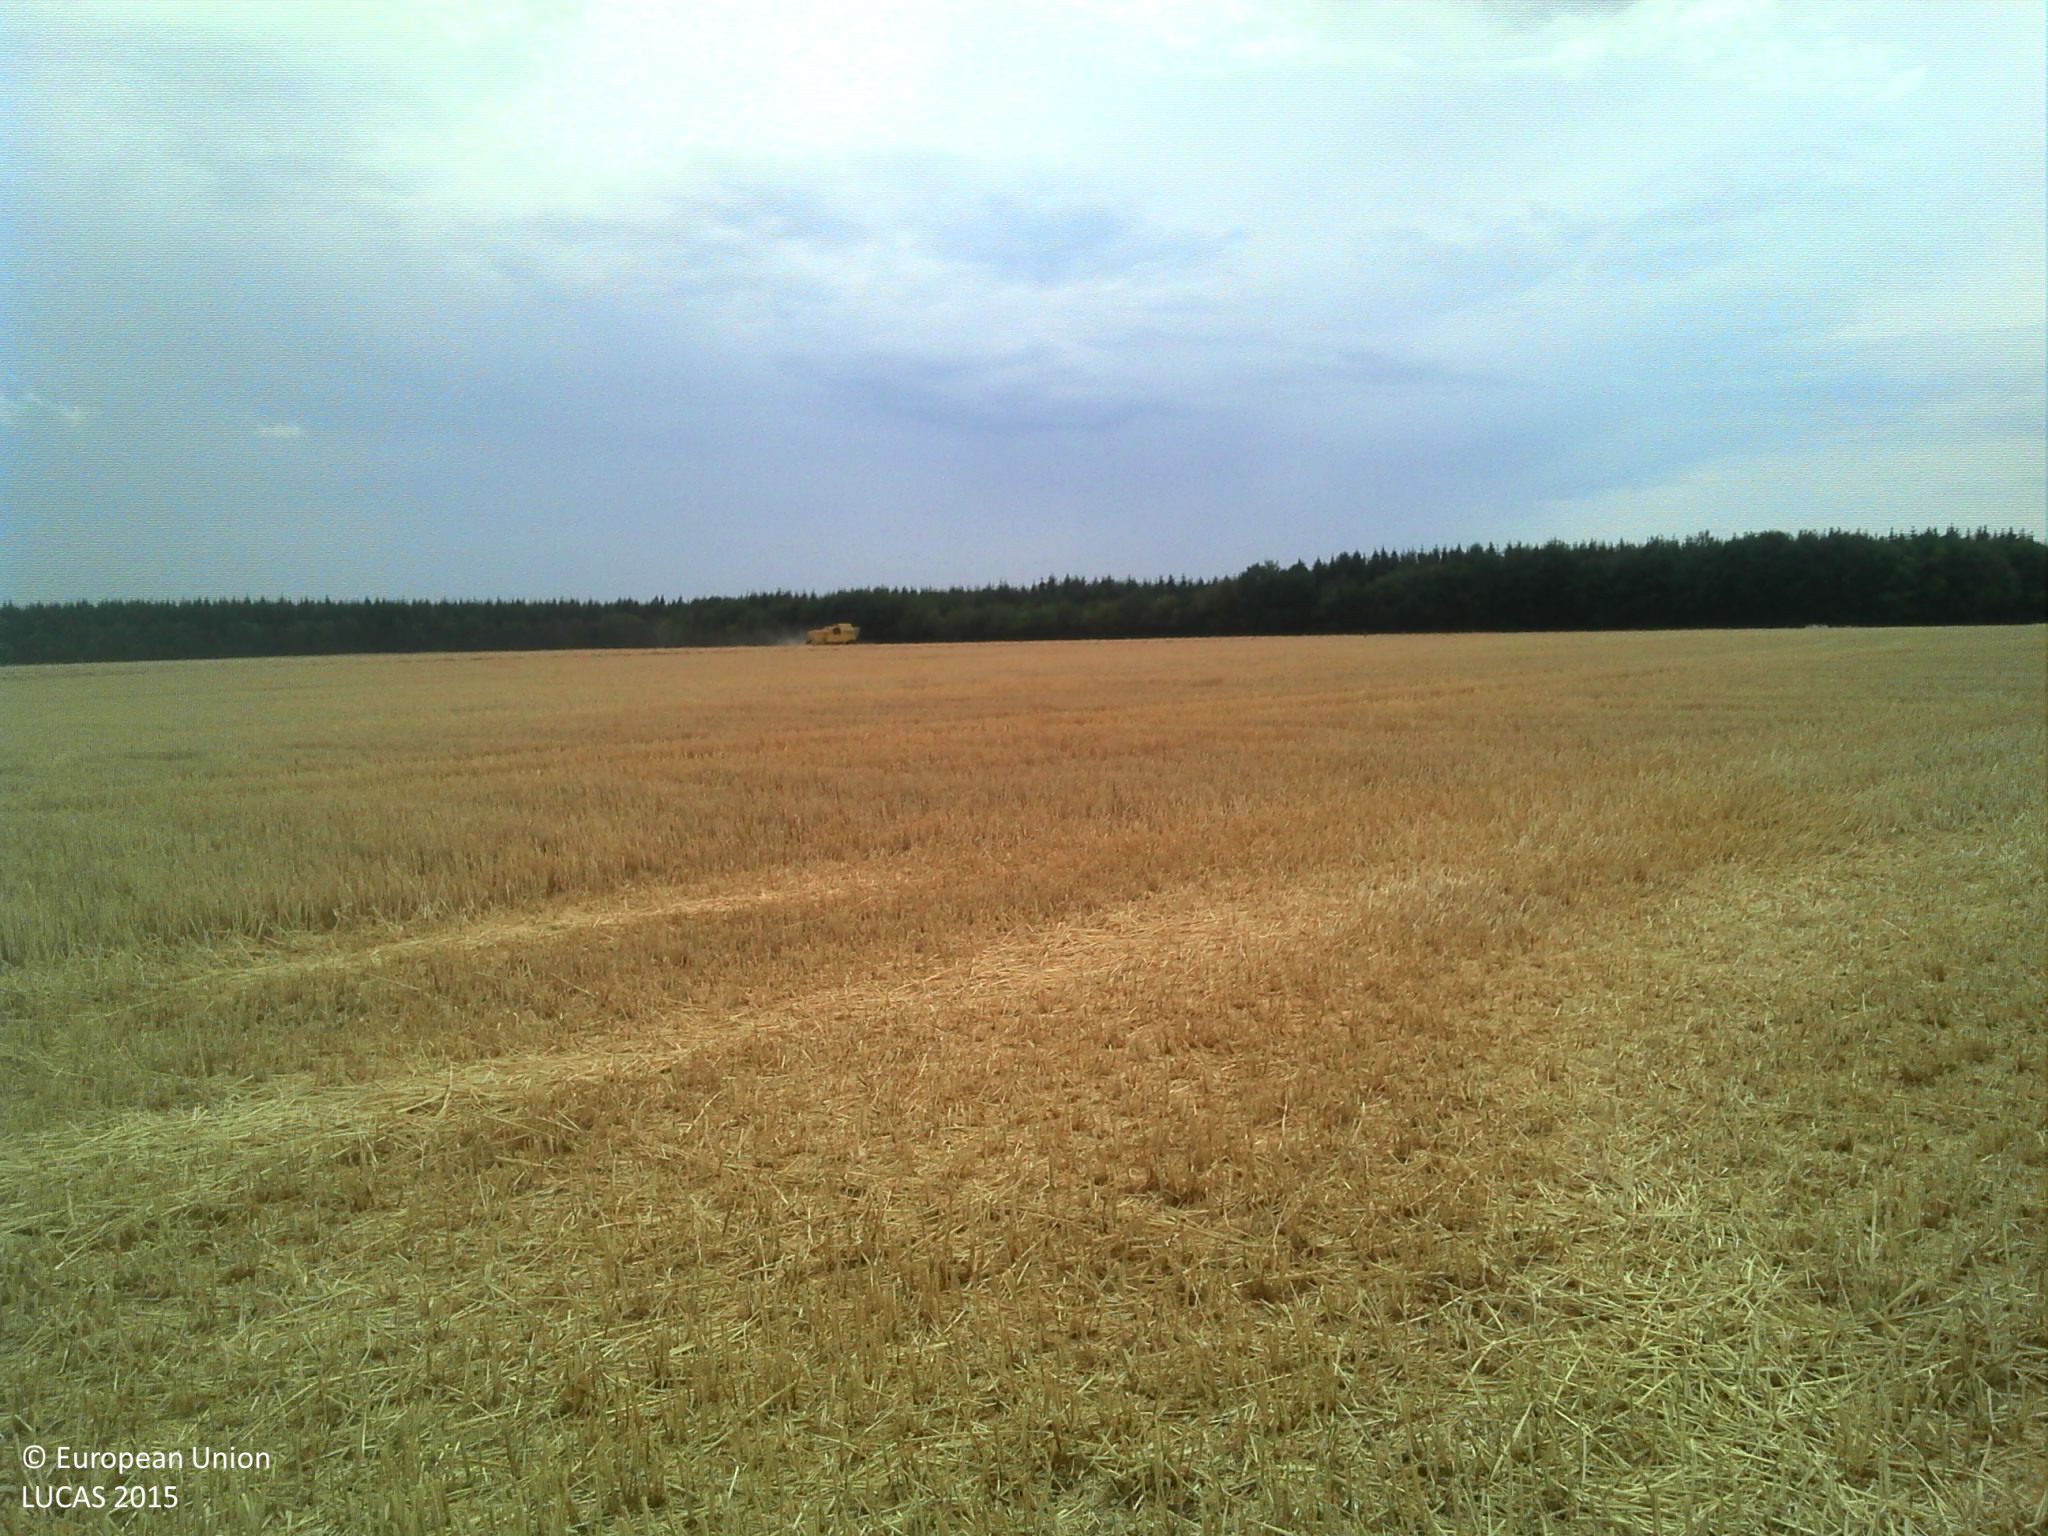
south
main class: Cropland
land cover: Common wheat
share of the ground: 10 - 25 %
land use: Agriculture (excluding fallow land and kitchen gardens)
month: July
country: FR
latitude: 47.9935
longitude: 5.2154
